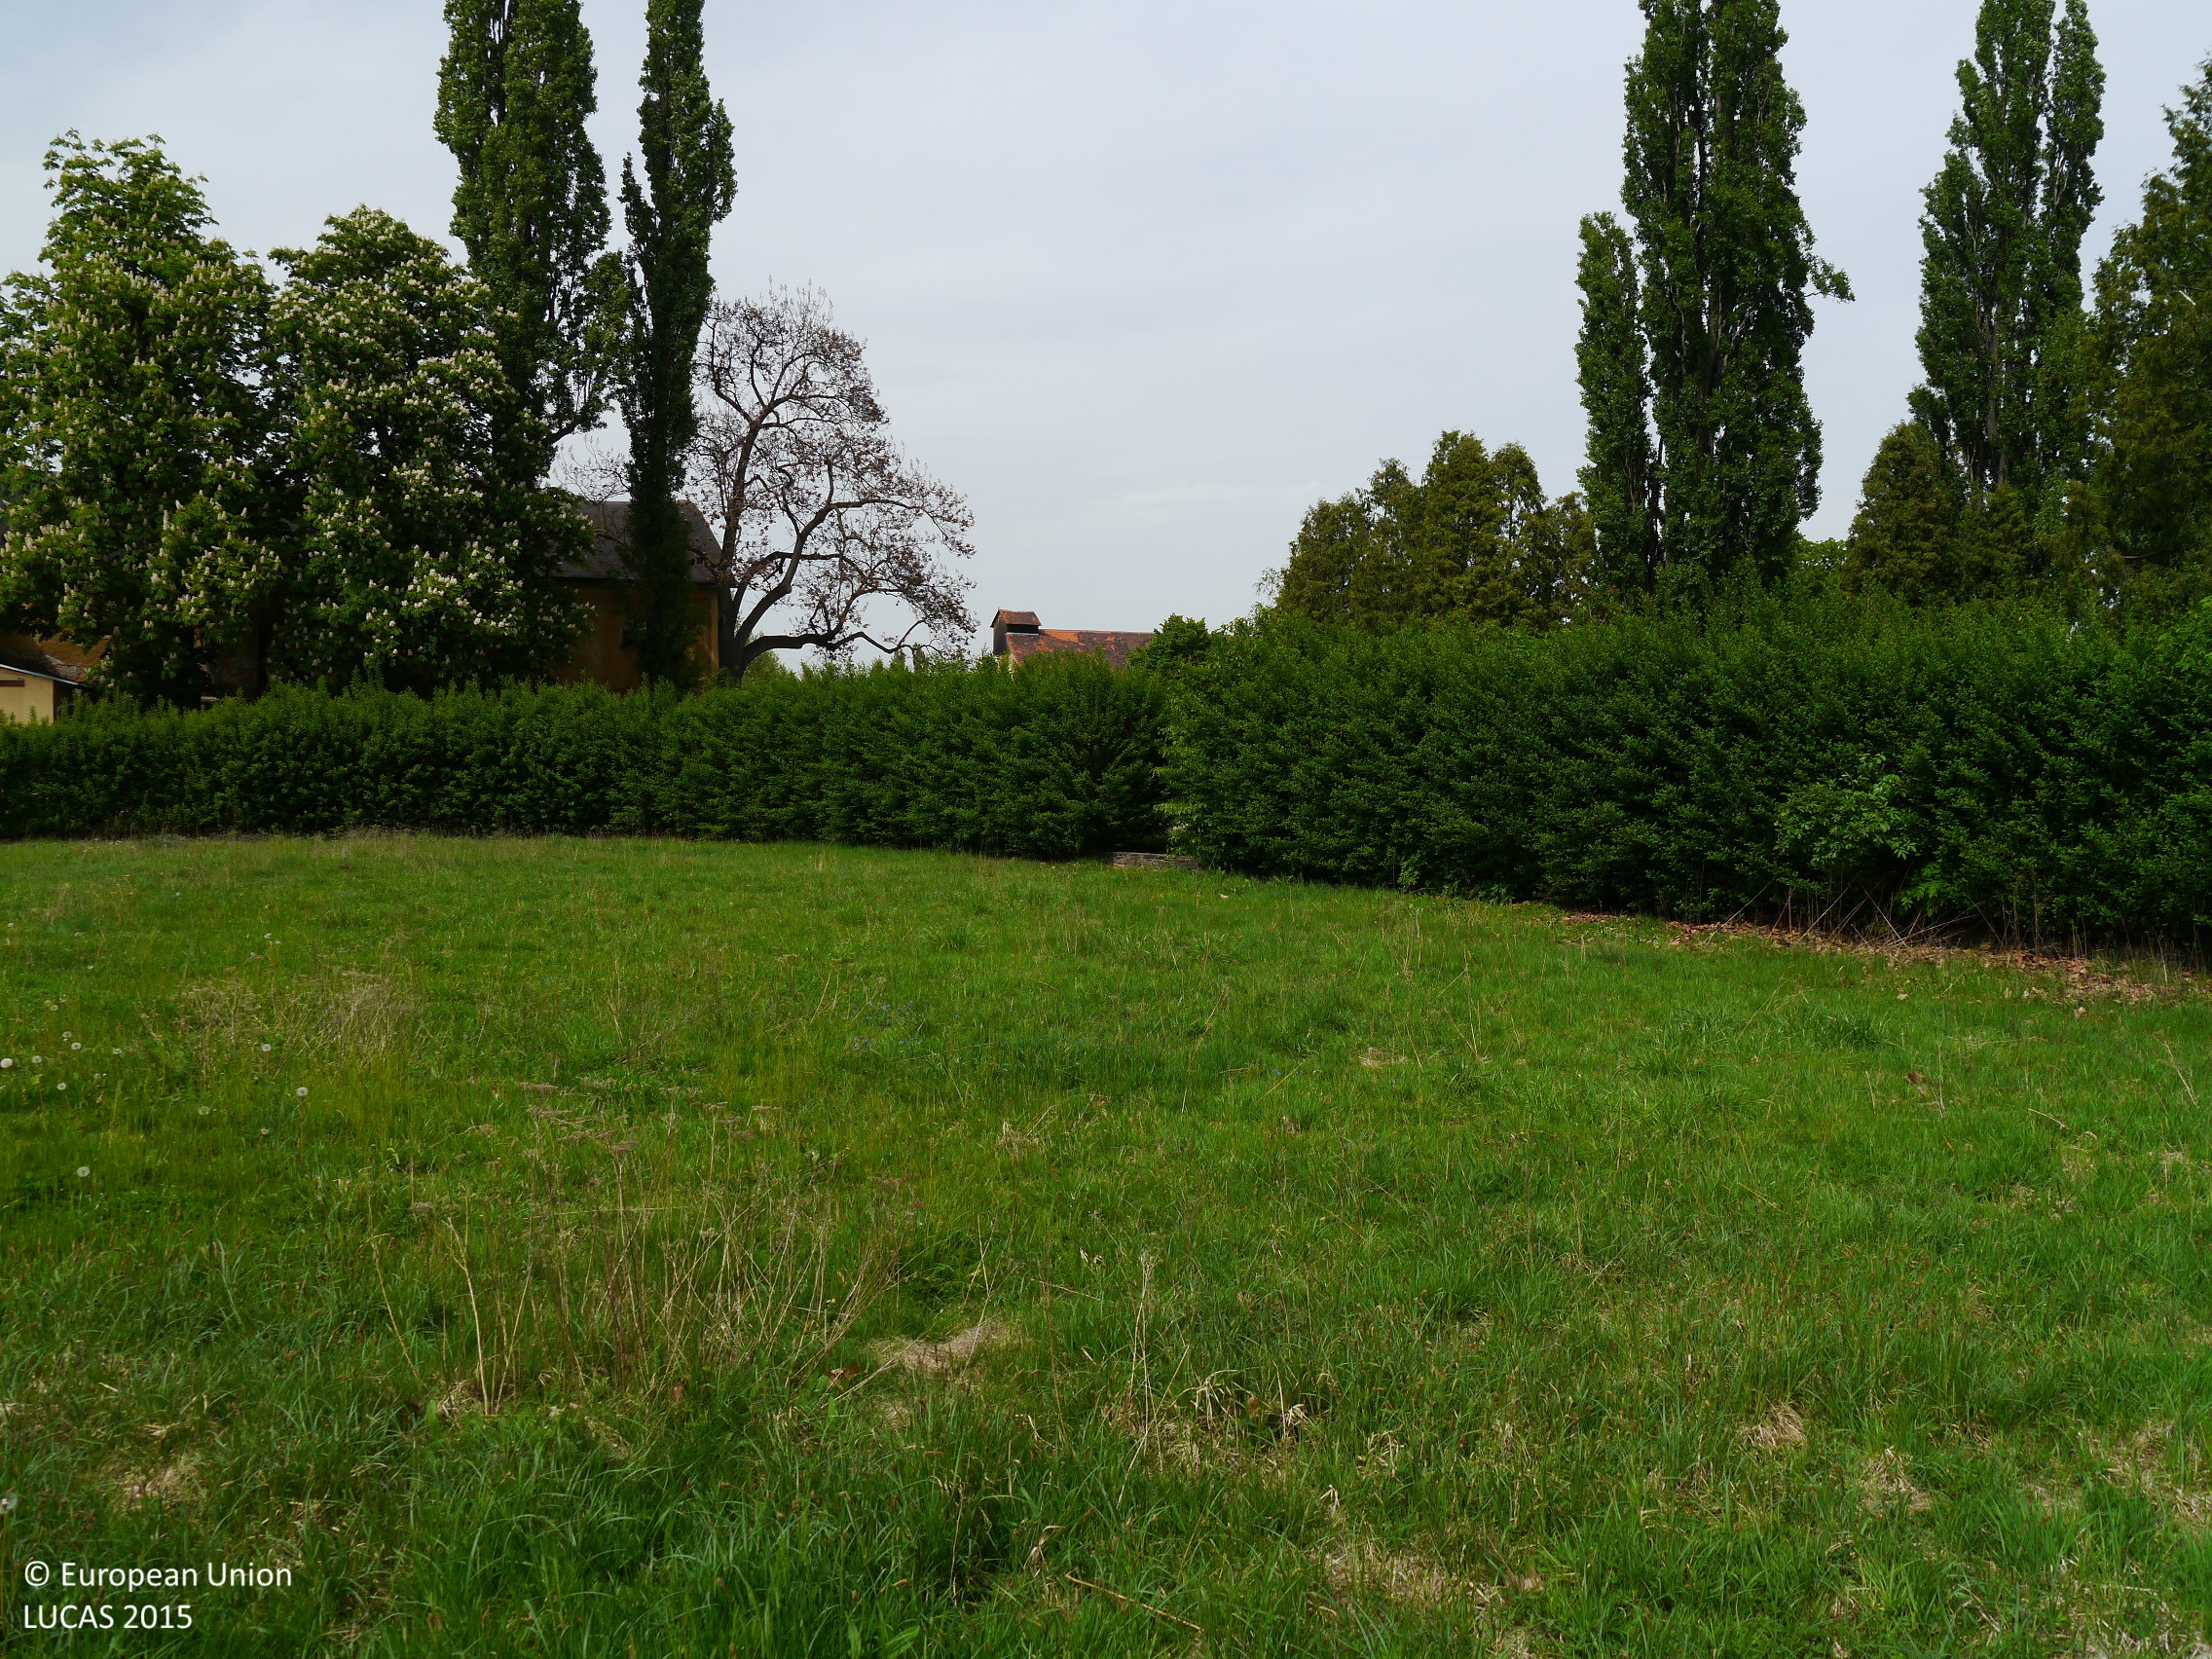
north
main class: Grassland
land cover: Grassland without tree/shrub cover
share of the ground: > 75 %
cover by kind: herbaceous plants 100 %
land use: Sport
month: May
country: AT
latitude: 47.0625
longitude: 15.4112
